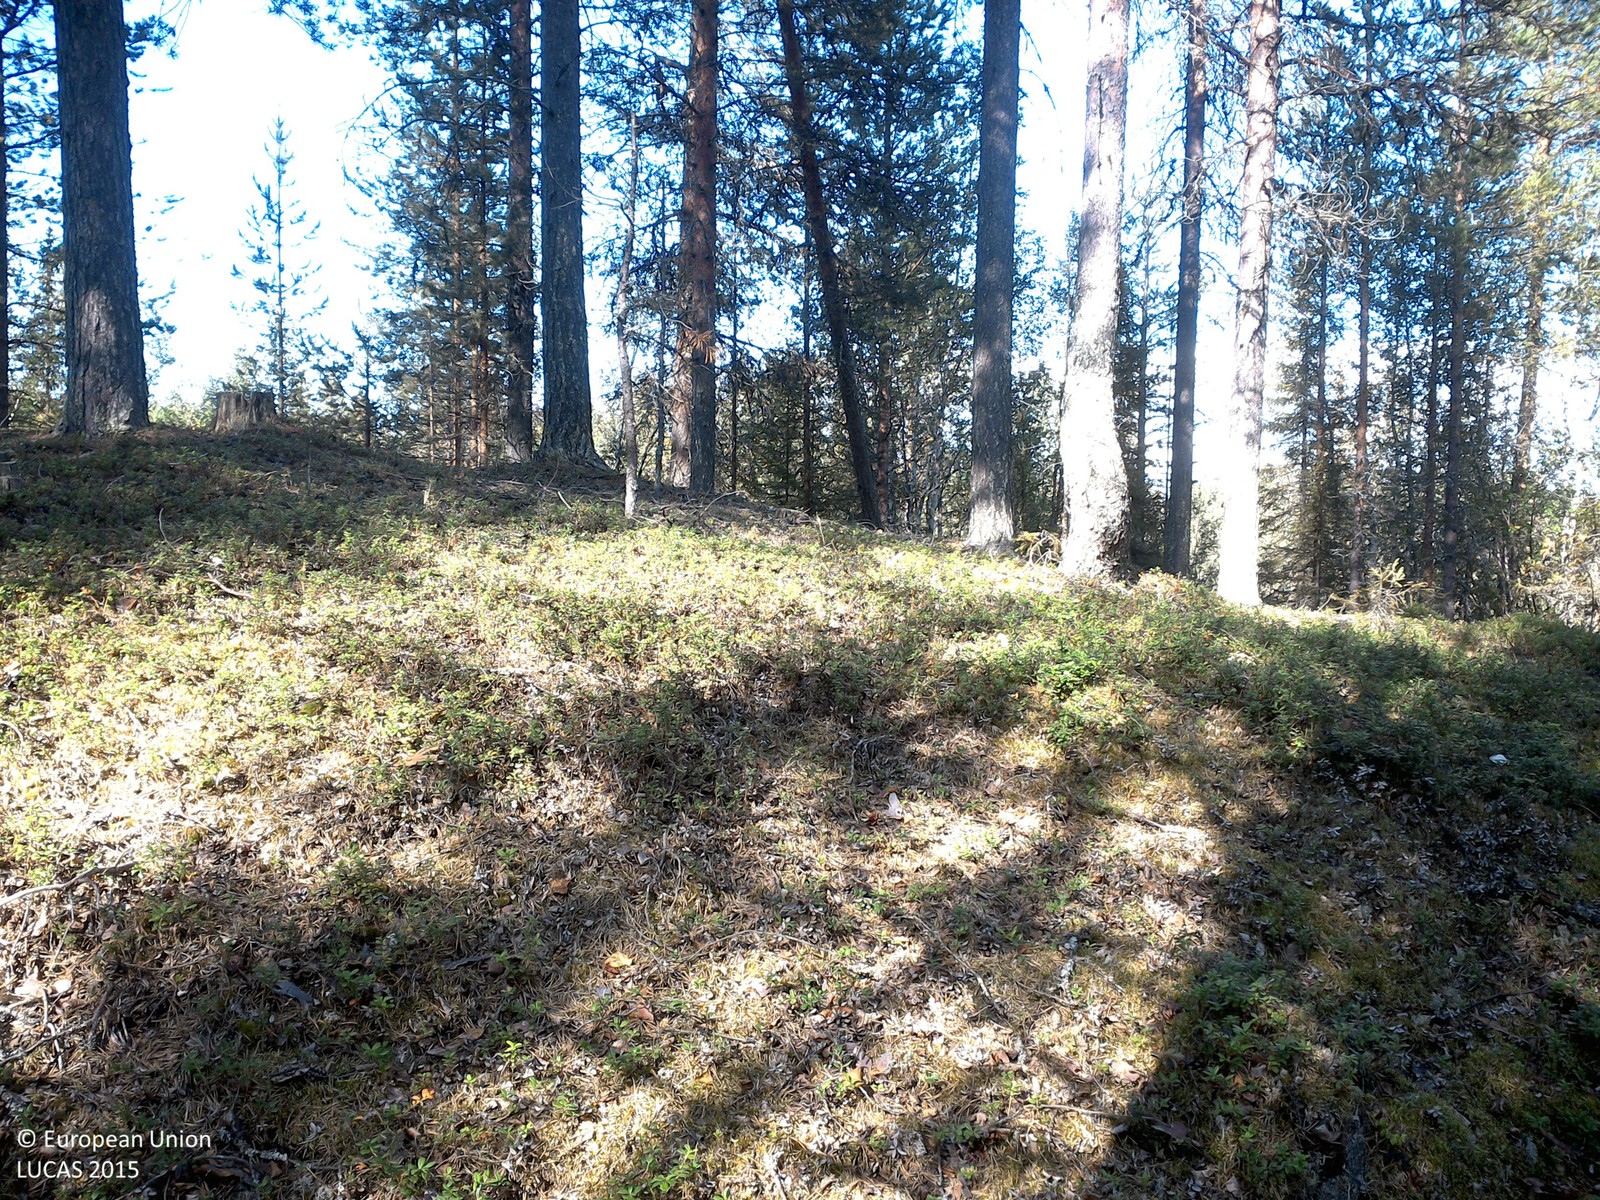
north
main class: Woodland
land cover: Pine dominated coniferous woodland
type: boreal forest
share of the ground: 25 - 50 %
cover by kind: shrubs 50 %, coniferous forest trees 35 %, lichens and mosses 15 %
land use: Forestry
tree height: > 5 m
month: August
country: SE
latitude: 67.0420
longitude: 21.9749
